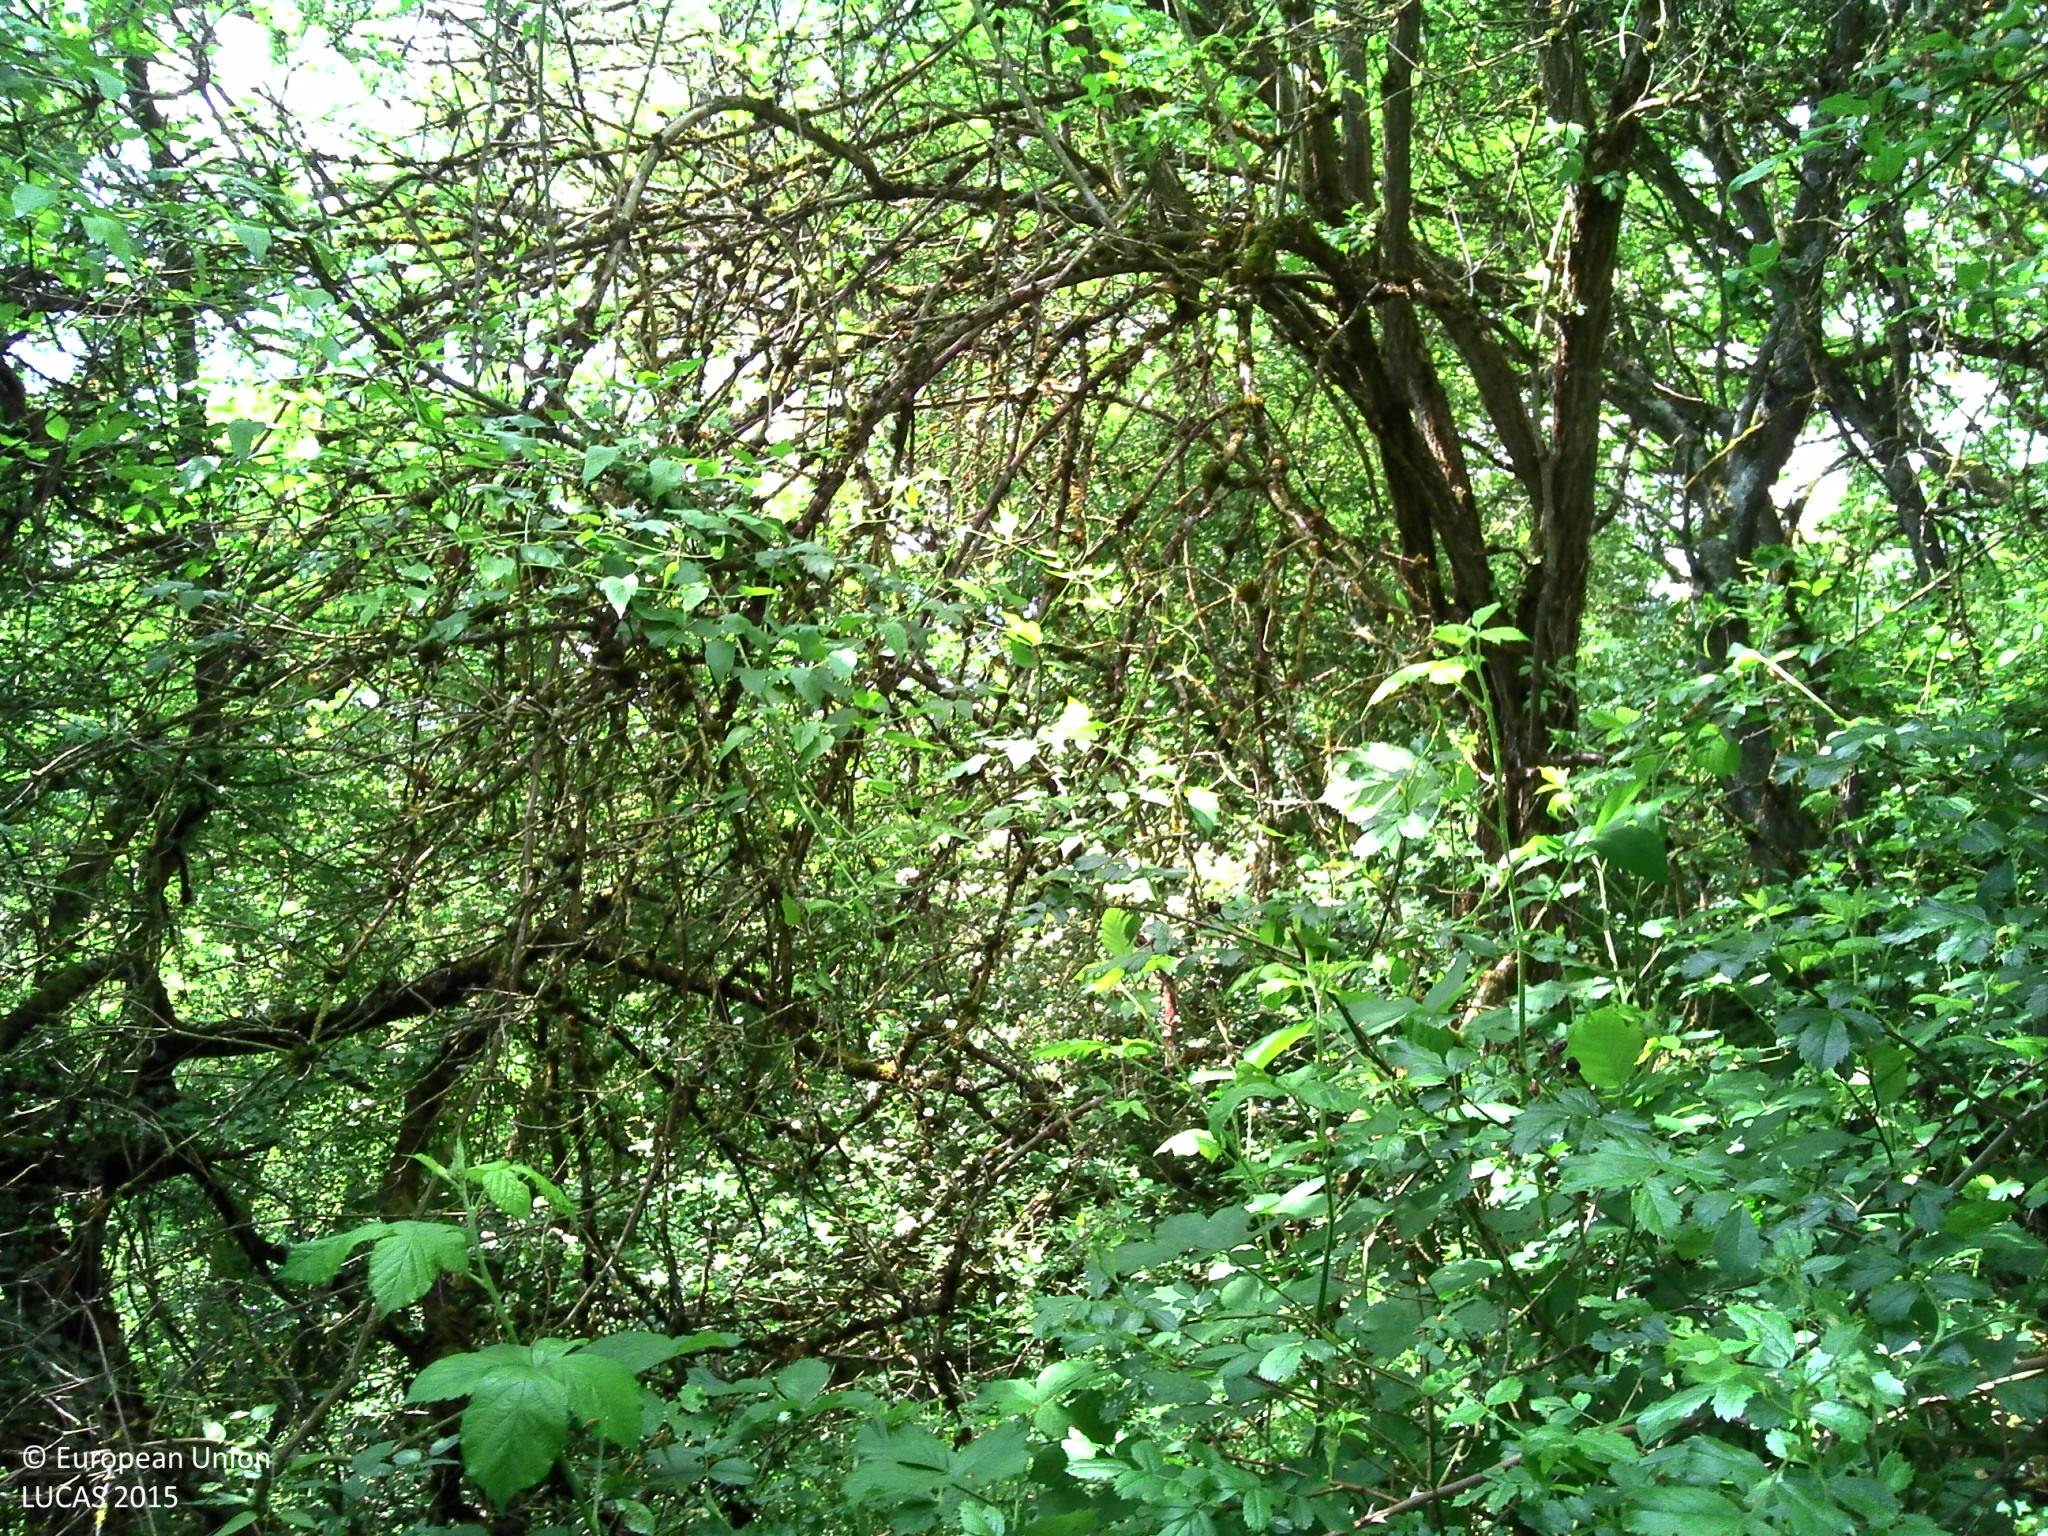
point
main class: Woodland
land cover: Broadleaved woodland
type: mesophytic deciduous forest
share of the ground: > 75 %
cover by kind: broadleaved forest trees 80 %, shrubs 20 %
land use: Semi-natural and natural areas not in use
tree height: > 5 m
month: May
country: LU
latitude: 49.7163
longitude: 6.4908
